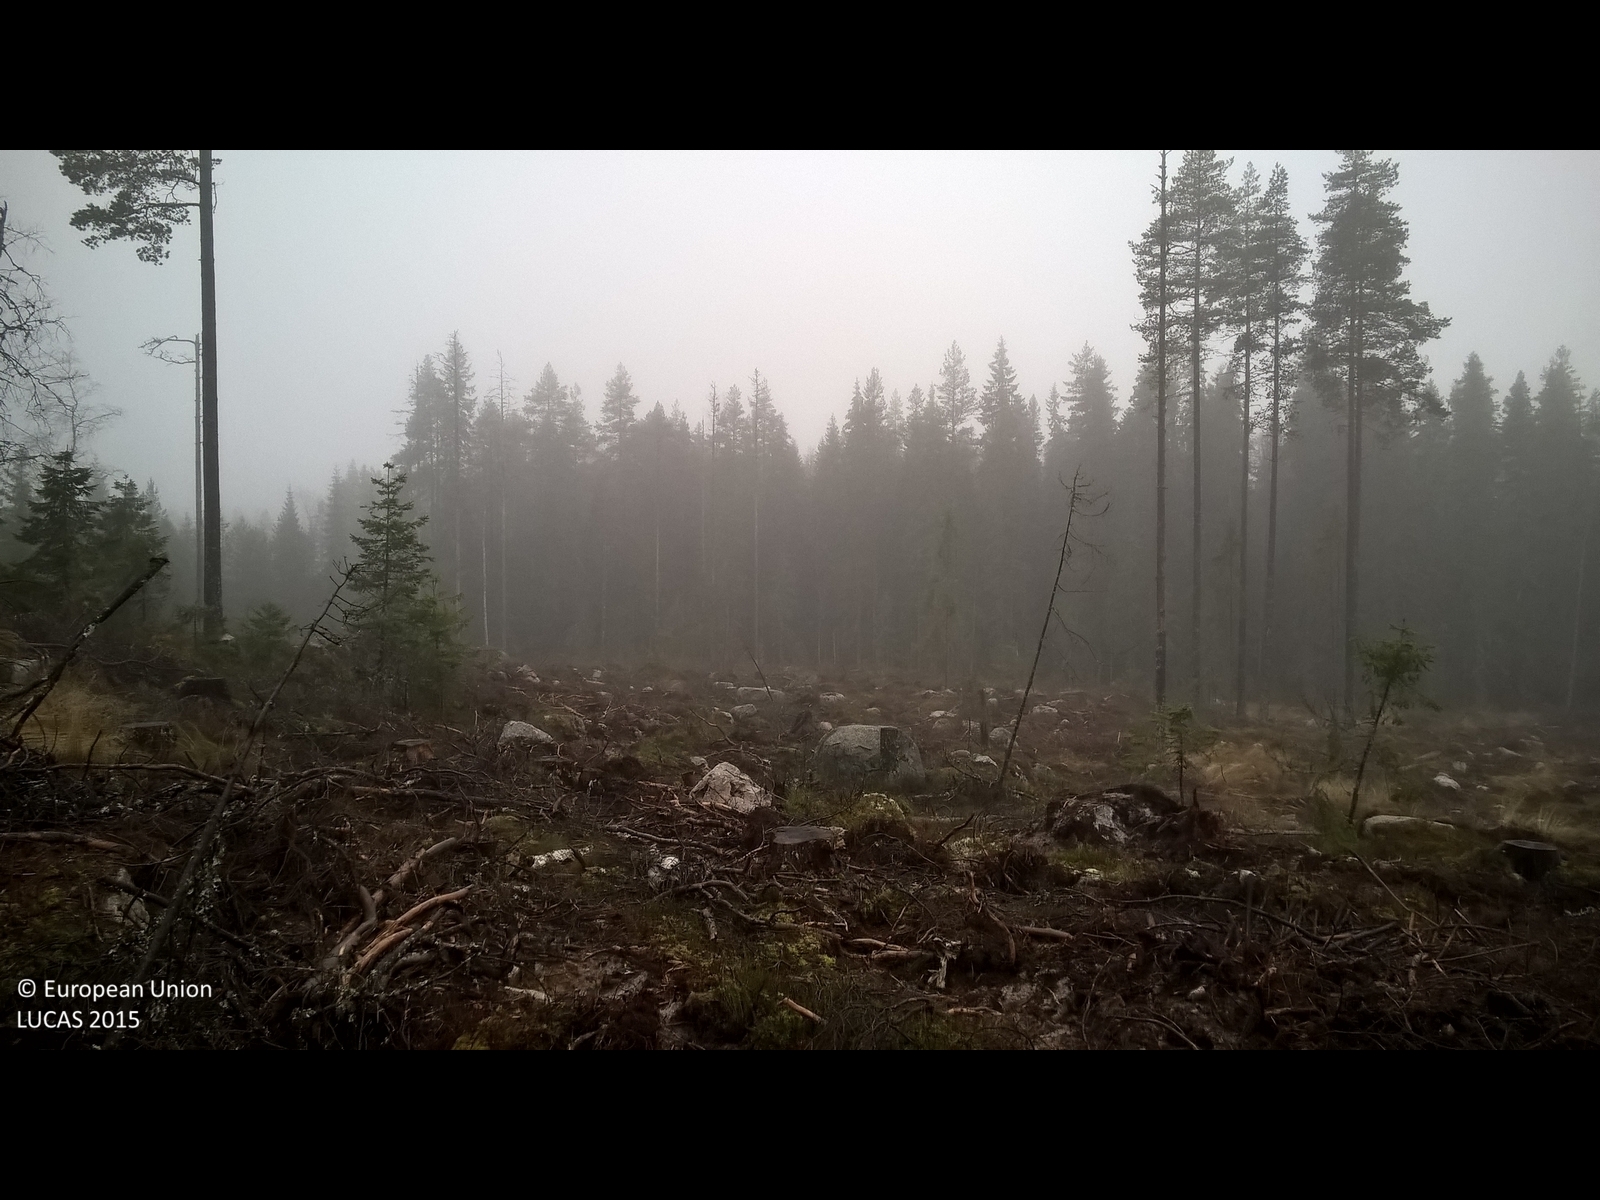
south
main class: Grassland
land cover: Grassland with sparse tree/shrub cover
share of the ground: > 75 %
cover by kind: lichens and mosses 55 %, herbaceous plants 30 %, shrubs 10 %, coniferous forest trees 5 %
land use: Forestry
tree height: > 5 m
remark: Clear cut
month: November
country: SE
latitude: 60.0908
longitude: 14.5022
